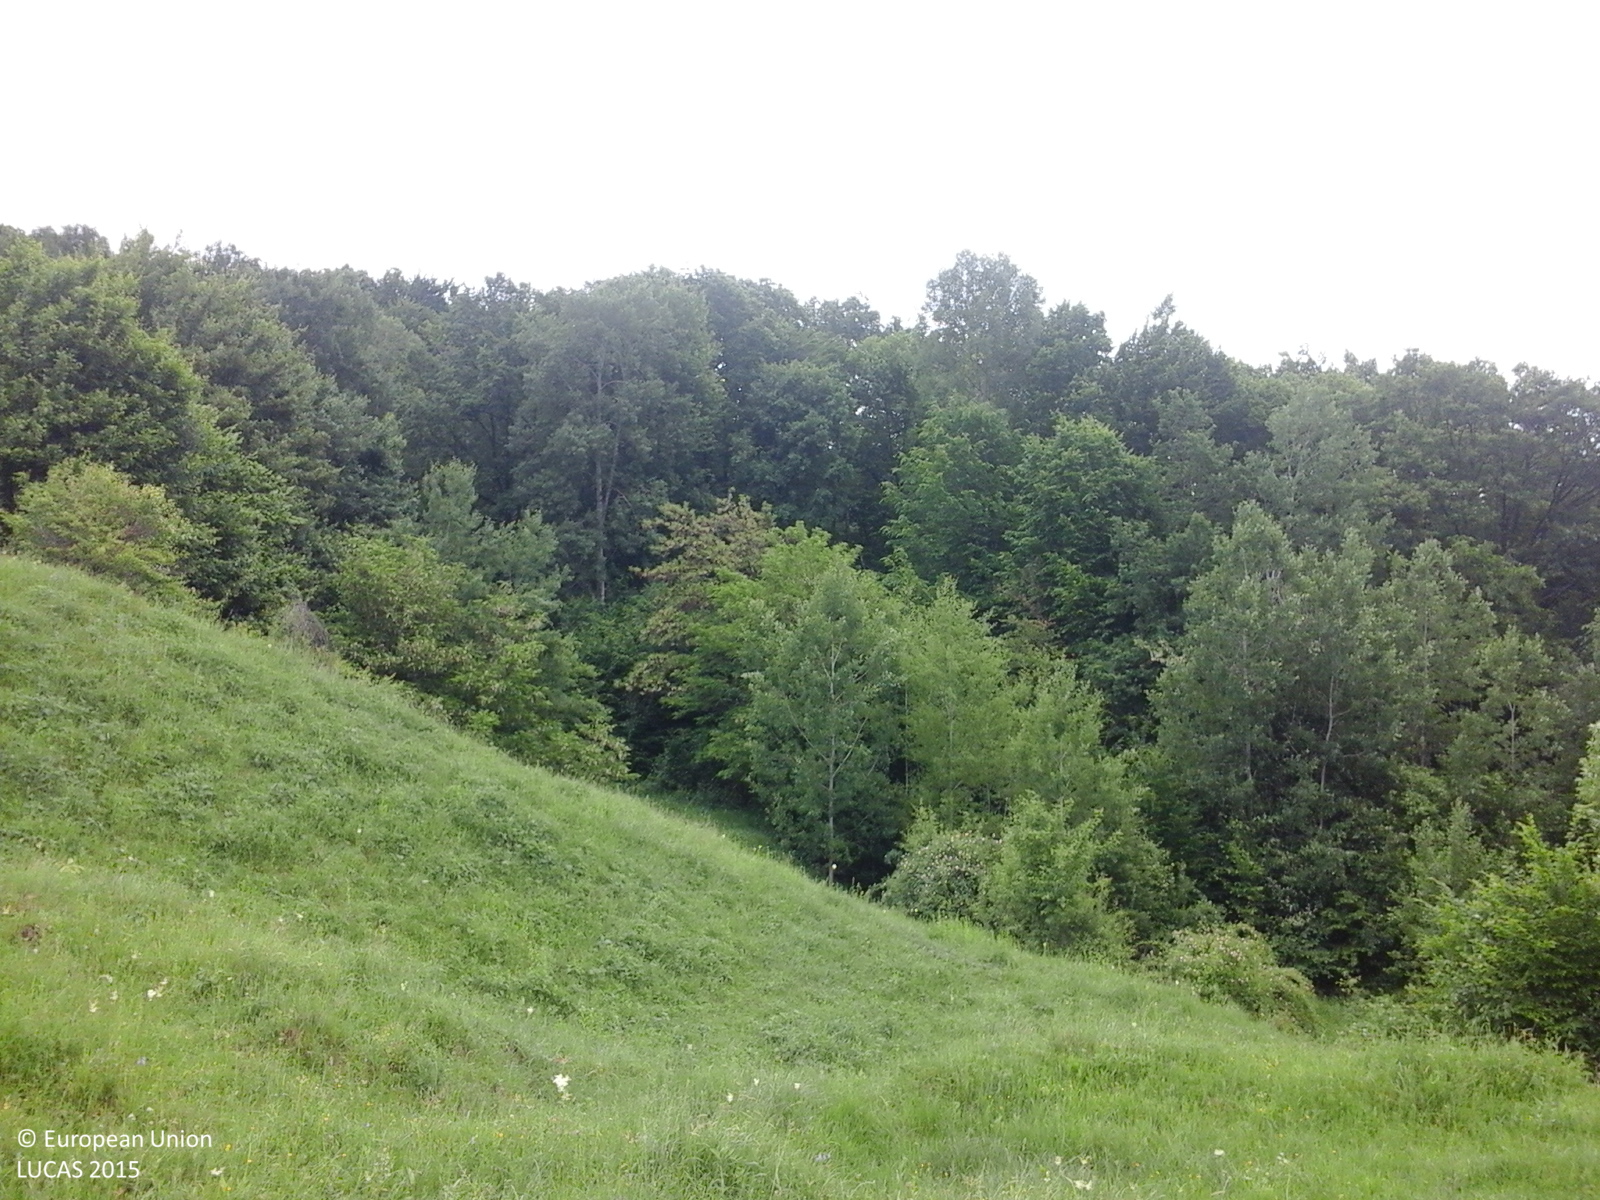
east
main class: Grassland
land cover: Grassland with sparse tree/shrub cover
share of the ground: > 75 %
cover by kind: herbaceous plants 85 %, shrubs 10 %, broadleaved forest trees 5 %
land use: Agriculture (excluding fallow land and kitchen gardens)
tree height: < 5 m
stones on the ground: < 10 %
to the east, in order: Grassland with sparse tree/shrub cover; Broadleaved woodland; Tracks; Broadleaved woodland; Grassland with sparse tree/shrub cover
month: May
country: RO
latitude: 45.1967
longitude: 26.0877
